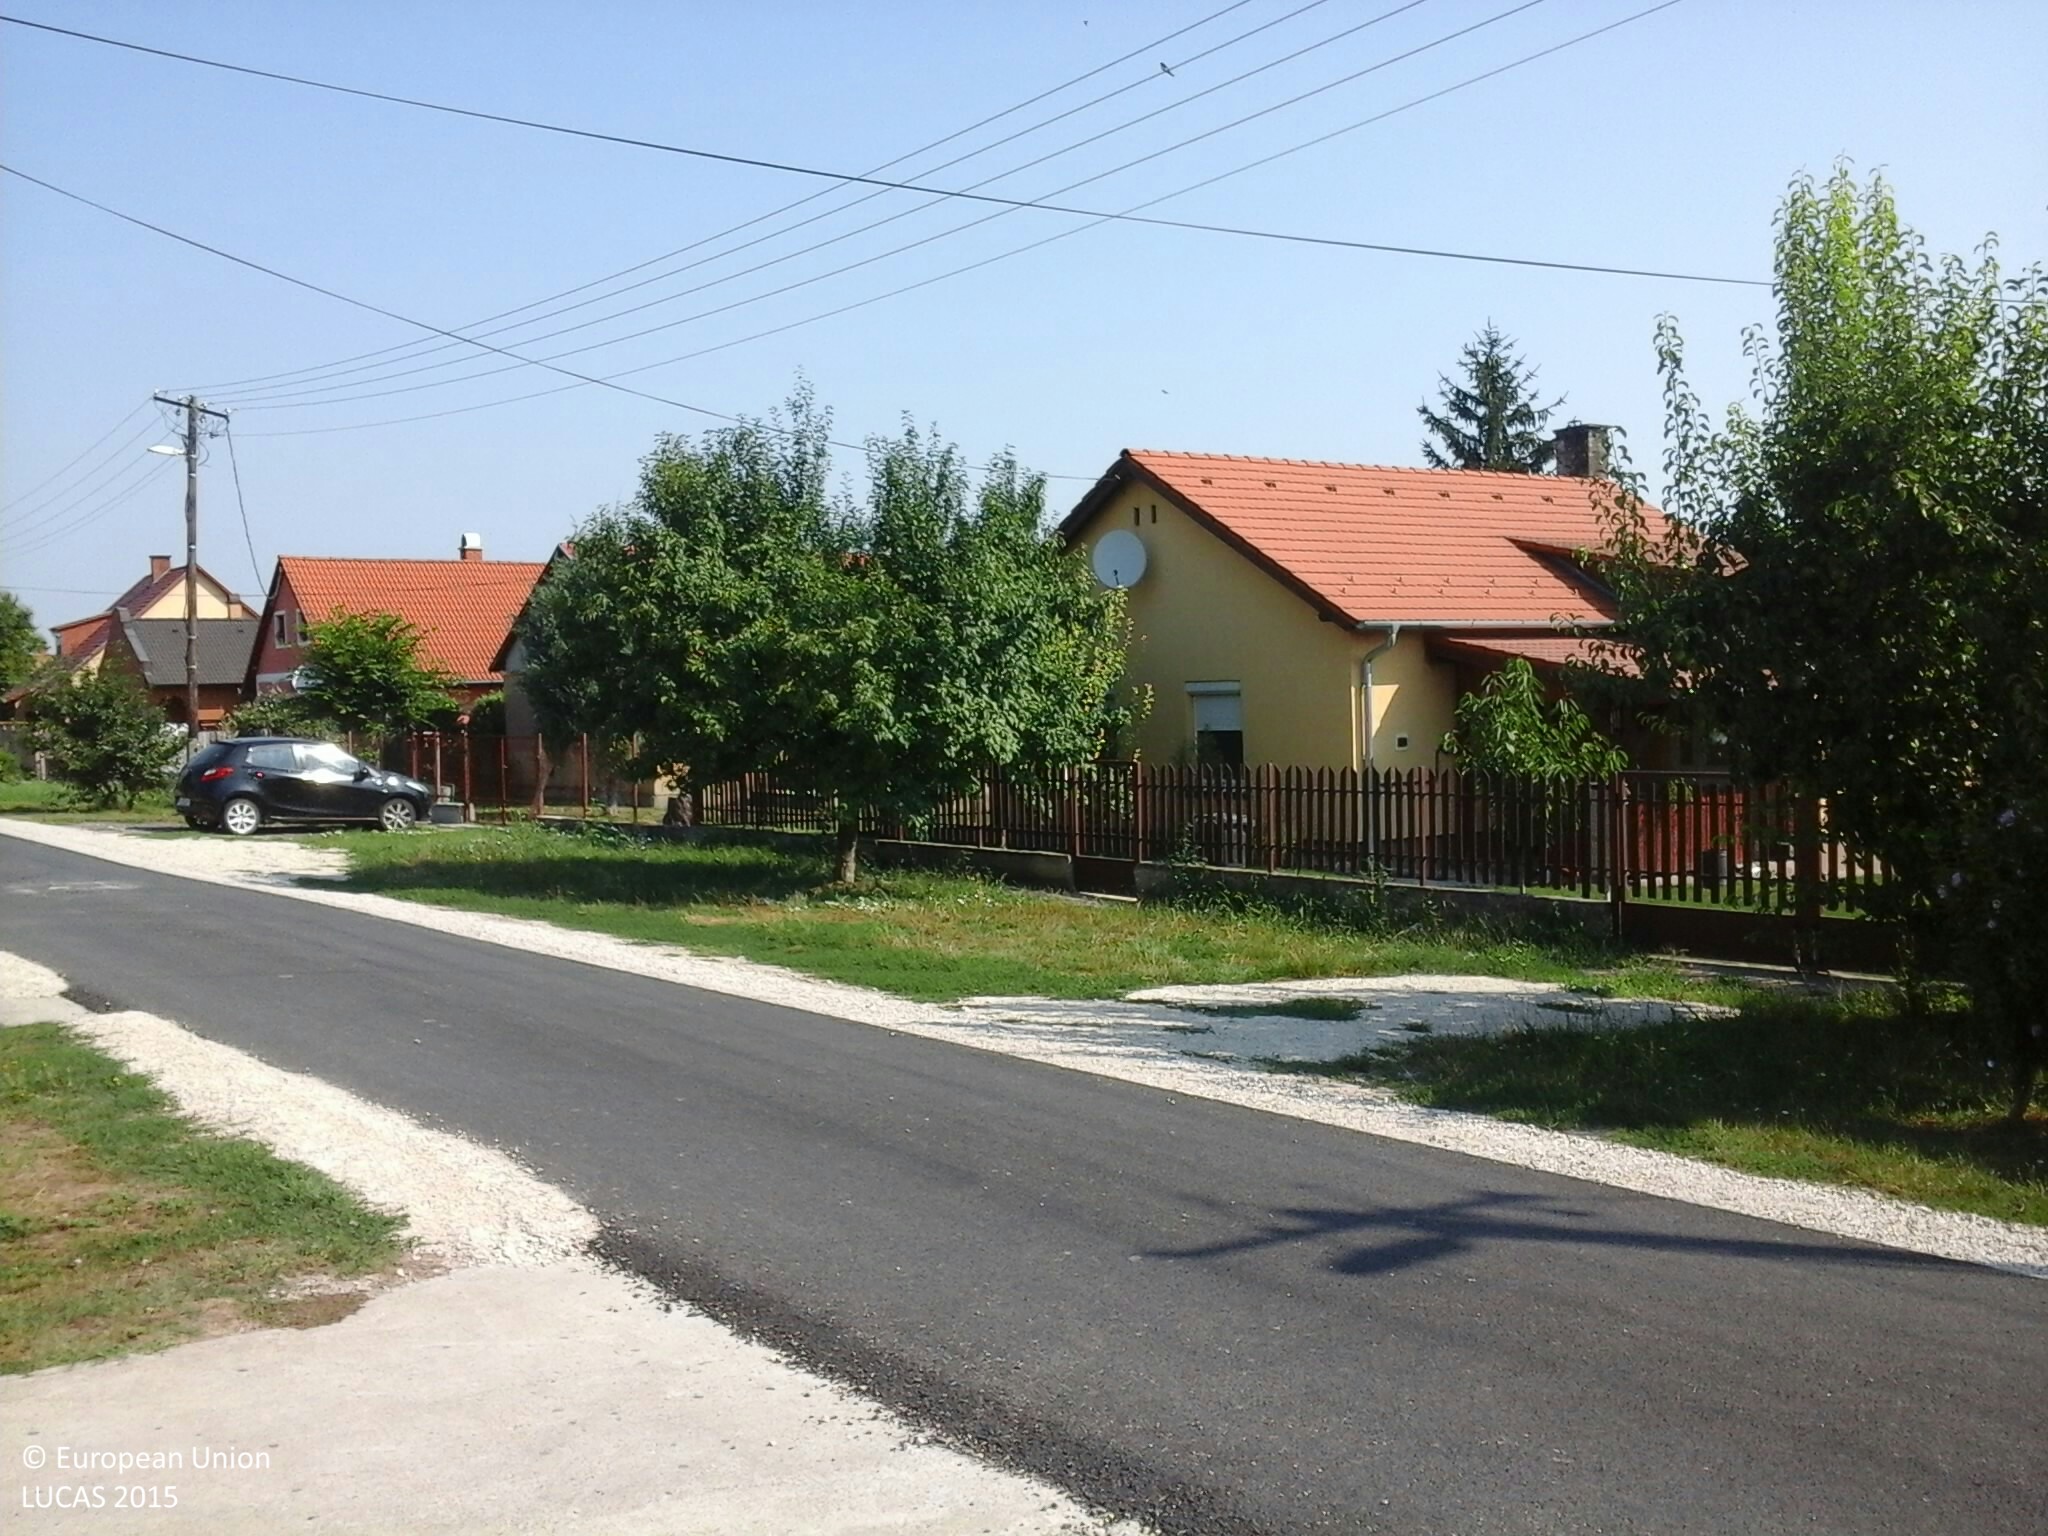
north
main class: Grassland
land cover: Grassland without tree/shrub cover
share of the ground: > 75 %
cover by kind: herbaceous plants 100 %
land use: Residential
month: August
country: HU
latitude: 46.9572
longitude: 18.2232
